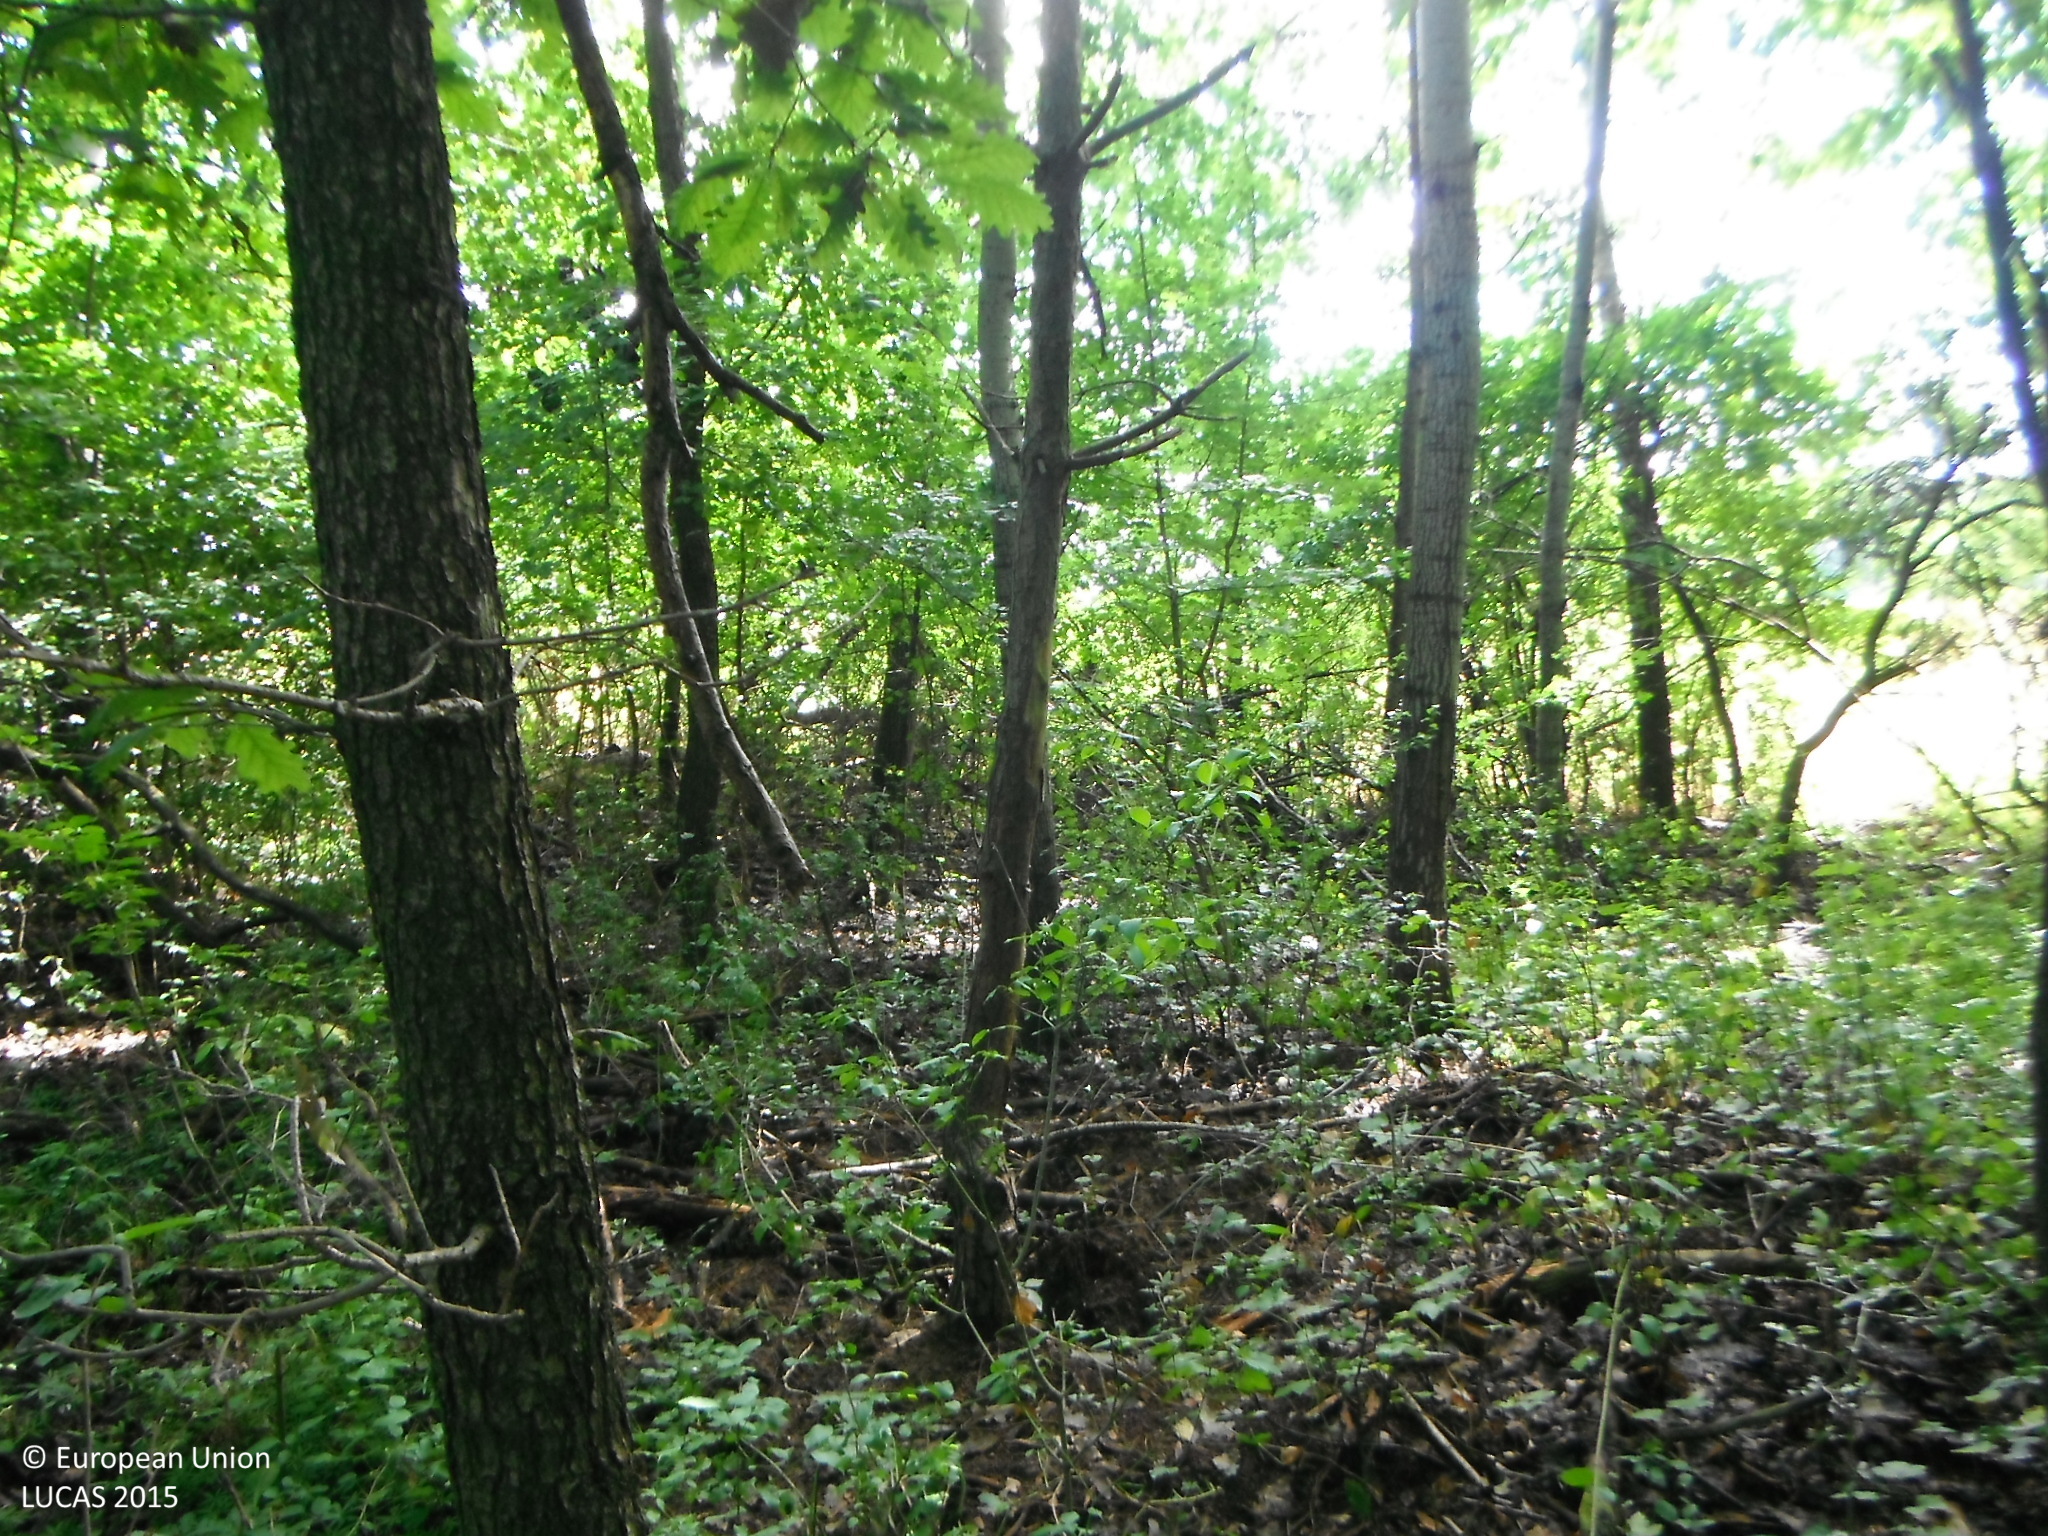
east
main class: Woodland
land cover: Broadleaved woodland
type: mesophytic deciduous forest
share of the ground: > 75 %
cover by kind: broadleaved forest trees 80 %, shrubs 10 %, herbaceous plants 10 %
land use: Forestry
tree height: > 5 m
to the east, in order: Broadleaved woodland; Barley; Common wheat
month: July
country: SK
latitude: 48.6668
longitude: 18.3396
